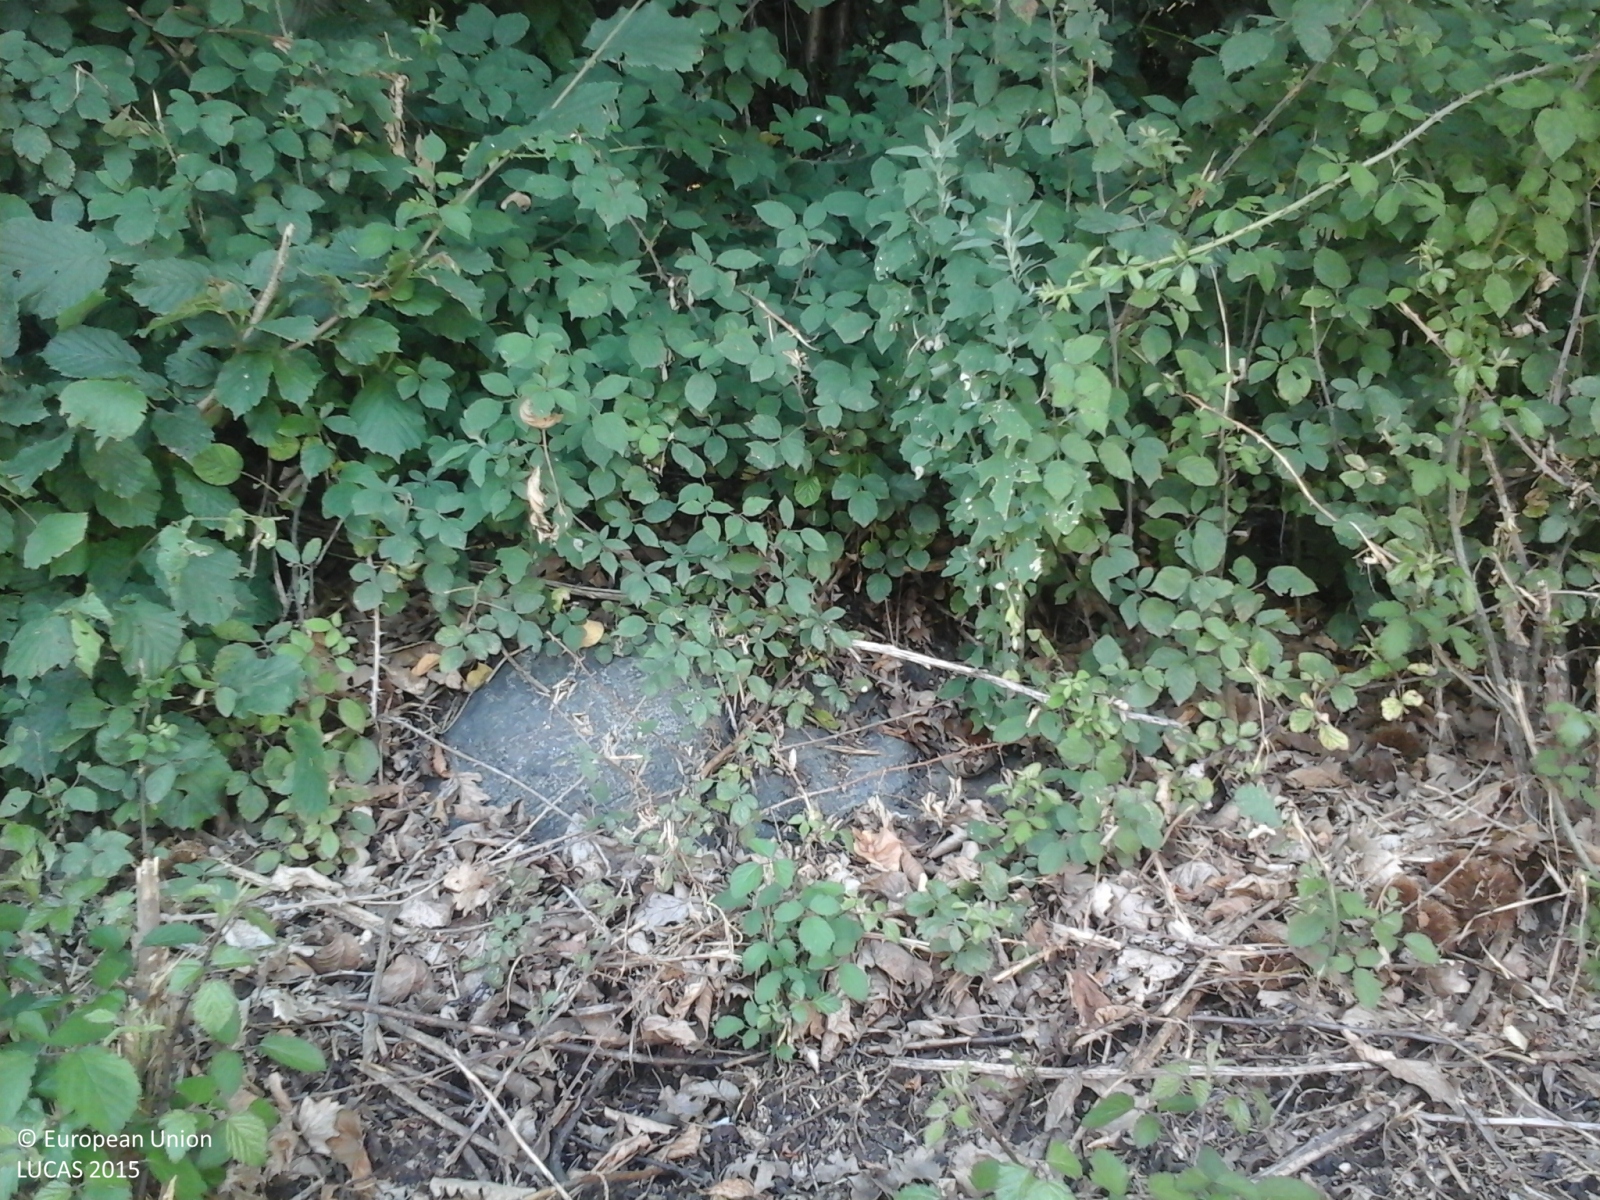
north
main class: Woodland
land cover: Broadleaved woodland
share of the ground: > 75 %
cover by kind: broadleaved forest trees 100 %
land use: Forestry
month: June
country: IT
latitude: 45.7313
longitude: 7.6774
